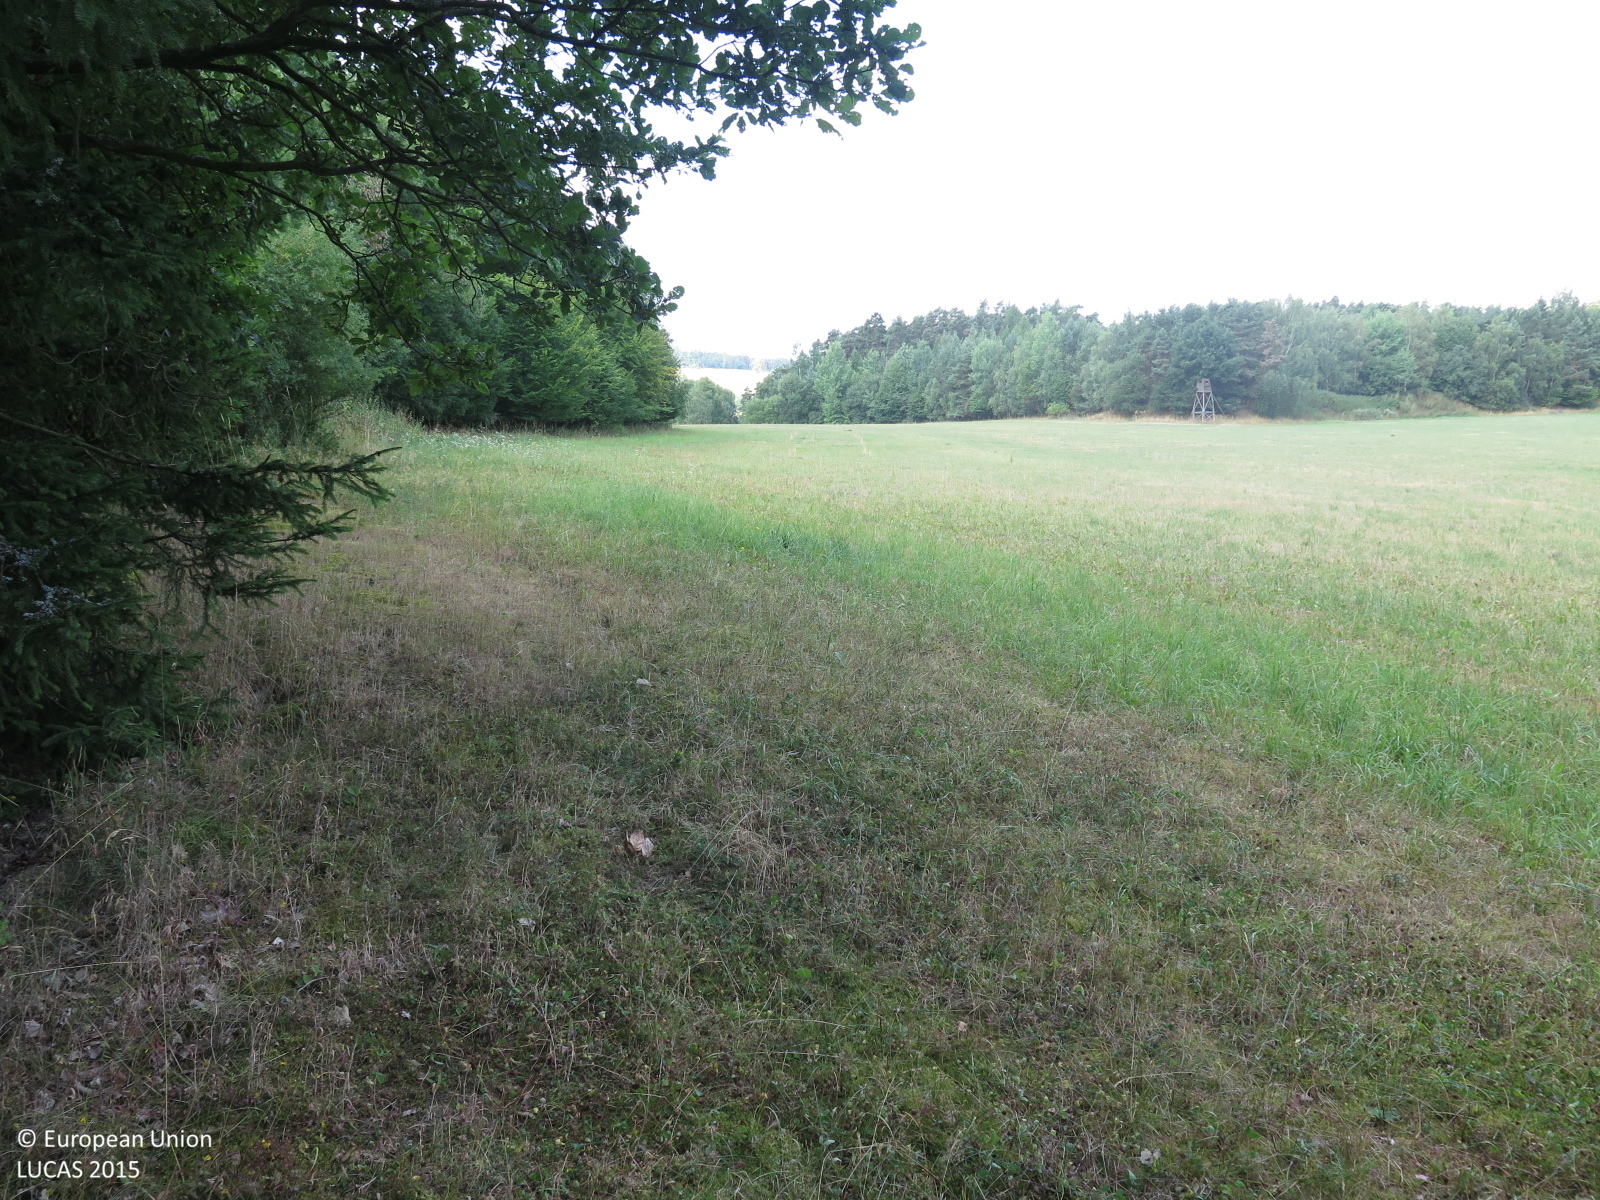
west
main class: Grassland
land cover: Grassland without tree/shrub cover
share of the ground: > 75 %
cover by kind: herbaceous plants 100 %
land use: Agriculture (excluding fallow land and kitchen gardens)
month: August
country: CZ
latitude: 50.0476
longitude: 13.8410
